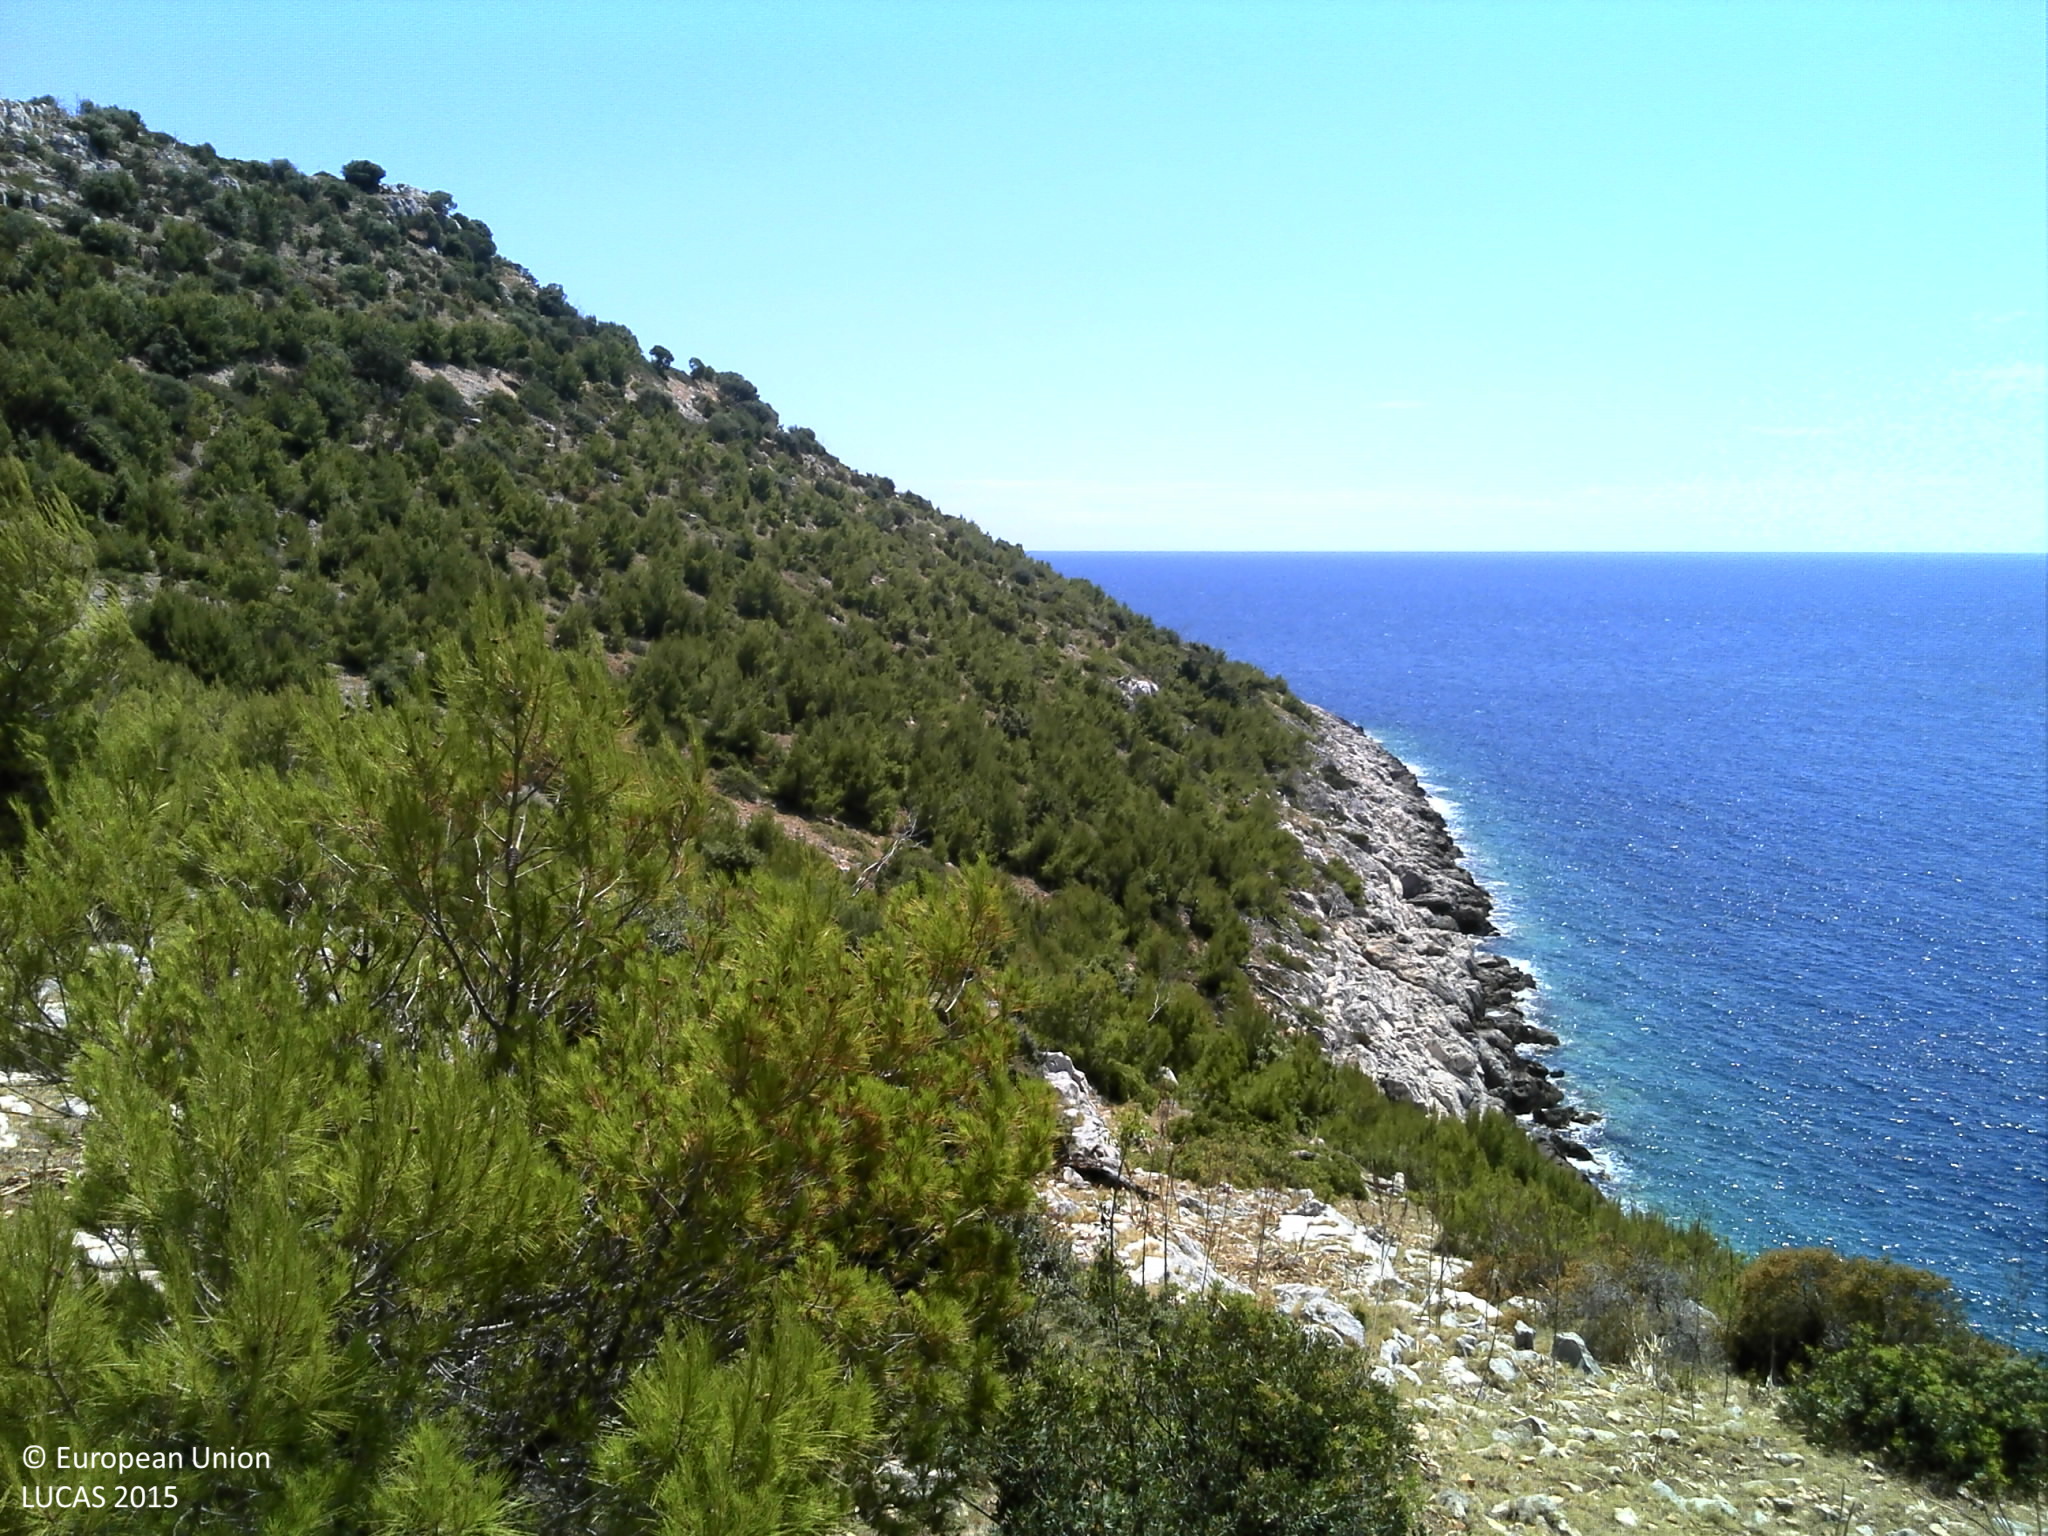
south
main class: Shrubland
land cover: Shrubland without tree cover
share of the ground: 50 - 75 %
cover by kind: shrubs 50 %, unconsolidated bare surface 25 %, consolidated bare surface 15 %, herbaceous plants 10 %
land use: Semi-natural and natural areas not in use
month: June
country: HR
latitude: 42.7307
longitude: 16.8396
